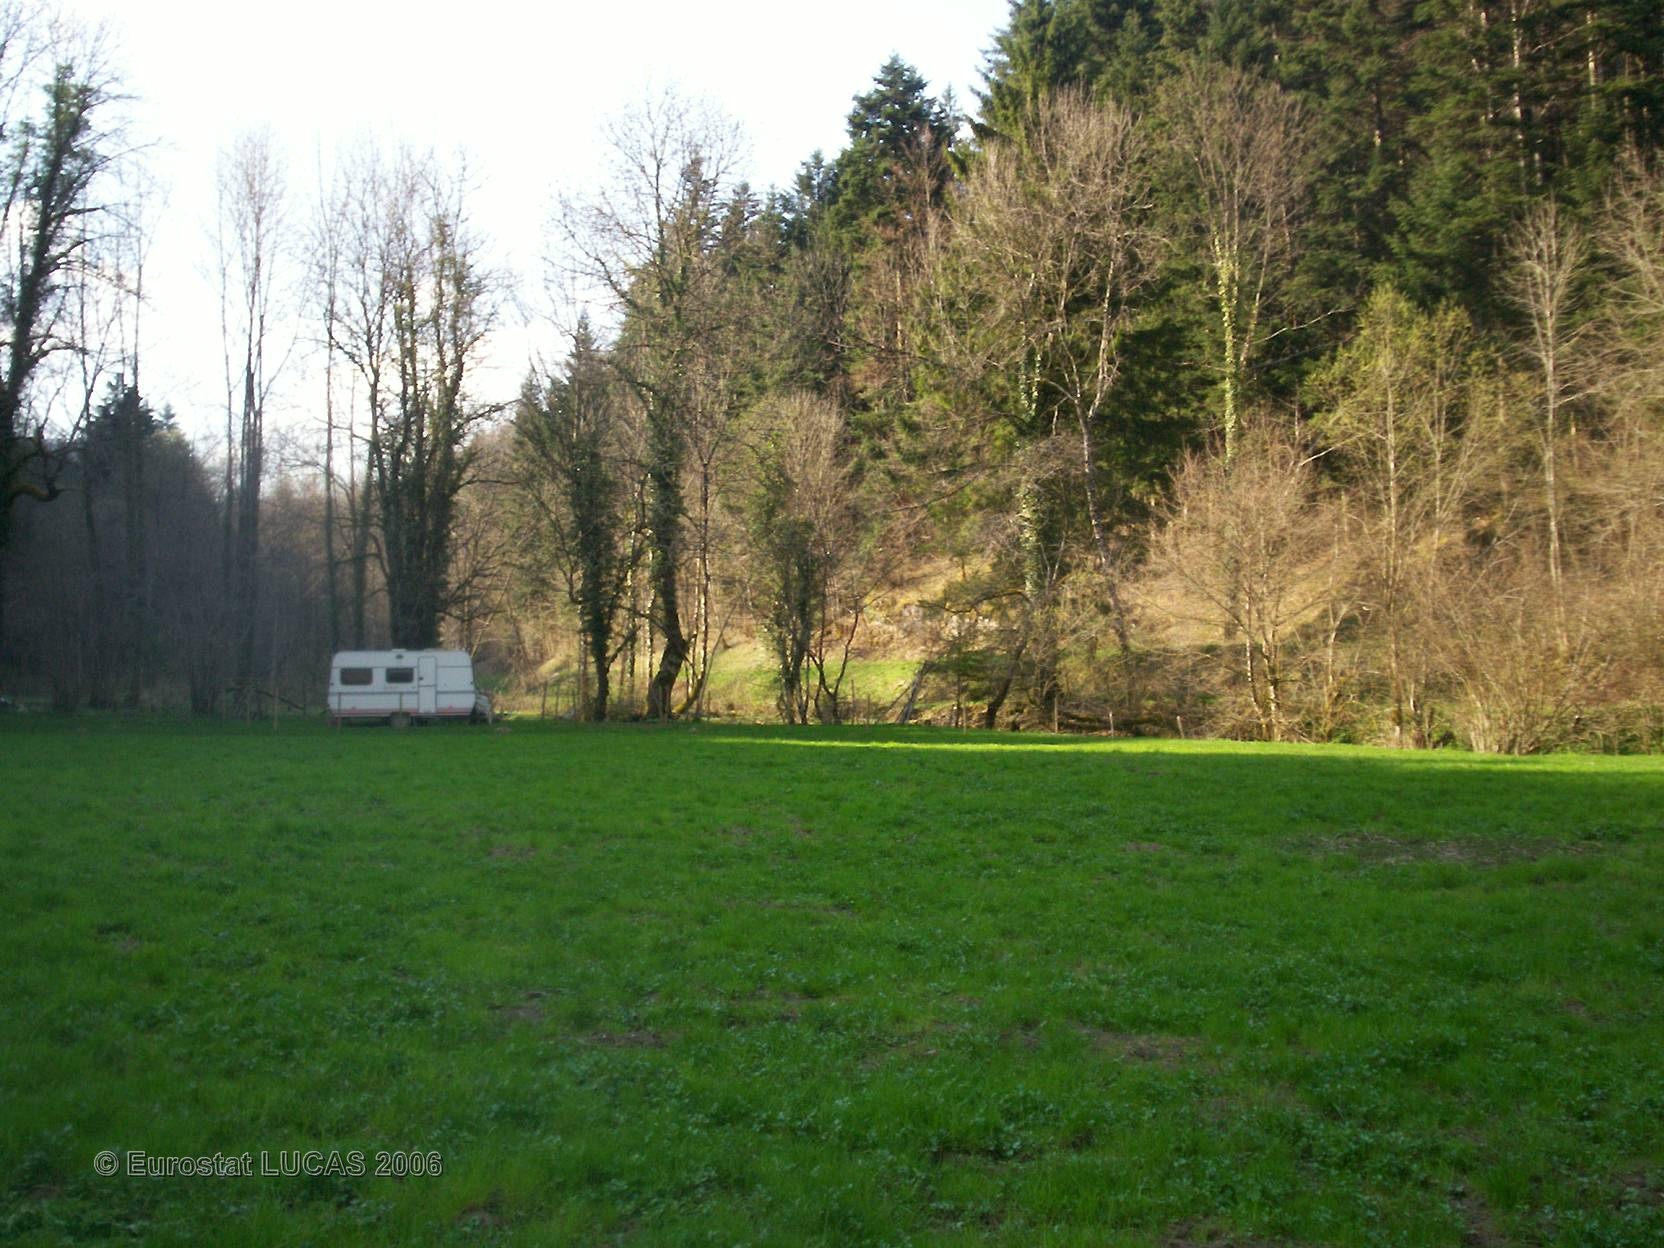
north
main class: Grassland
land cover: Grassland without tree/shrub cover
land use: Residential
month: April
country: FR
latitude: 47.3002
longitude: 6.9998
